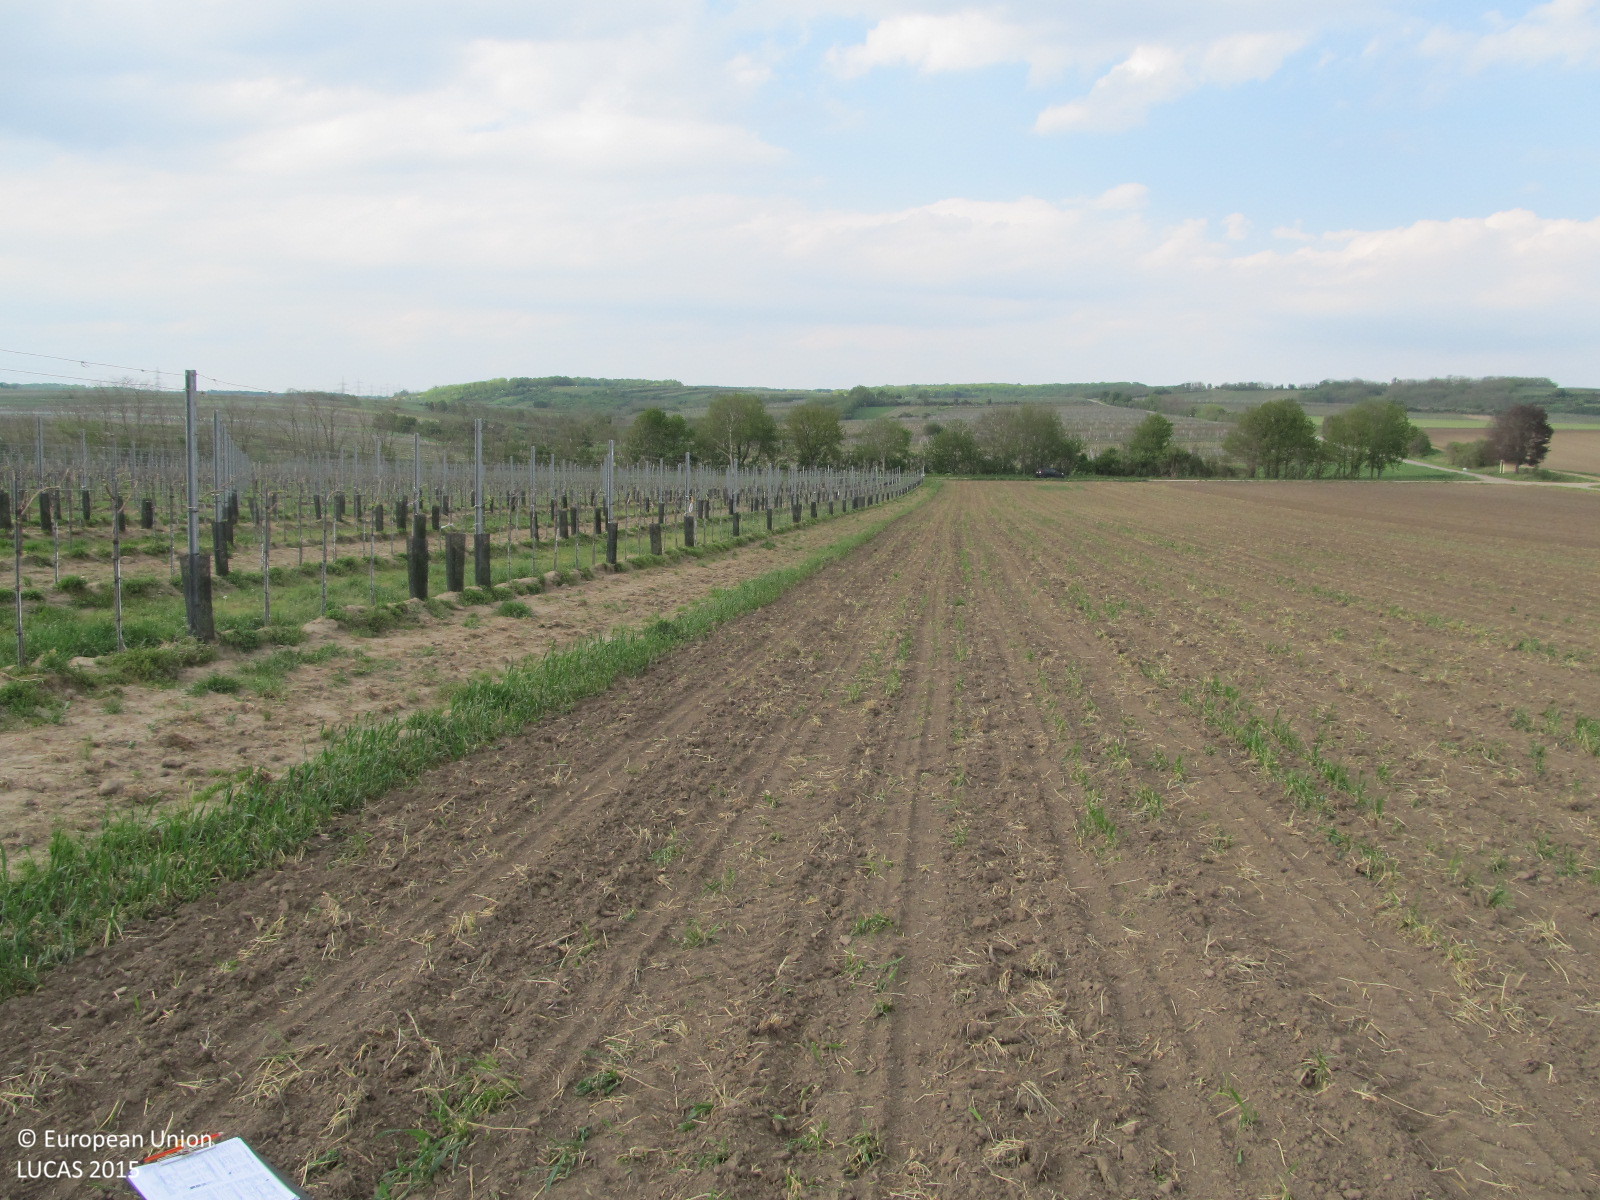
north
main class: Cropland
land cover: Maize
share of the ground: < 10 %
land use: Agriculture (excluding fallow land and kitchen gardens)
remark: Harvested field
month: May
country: AT
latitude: 48.4617
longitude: 15.9137
